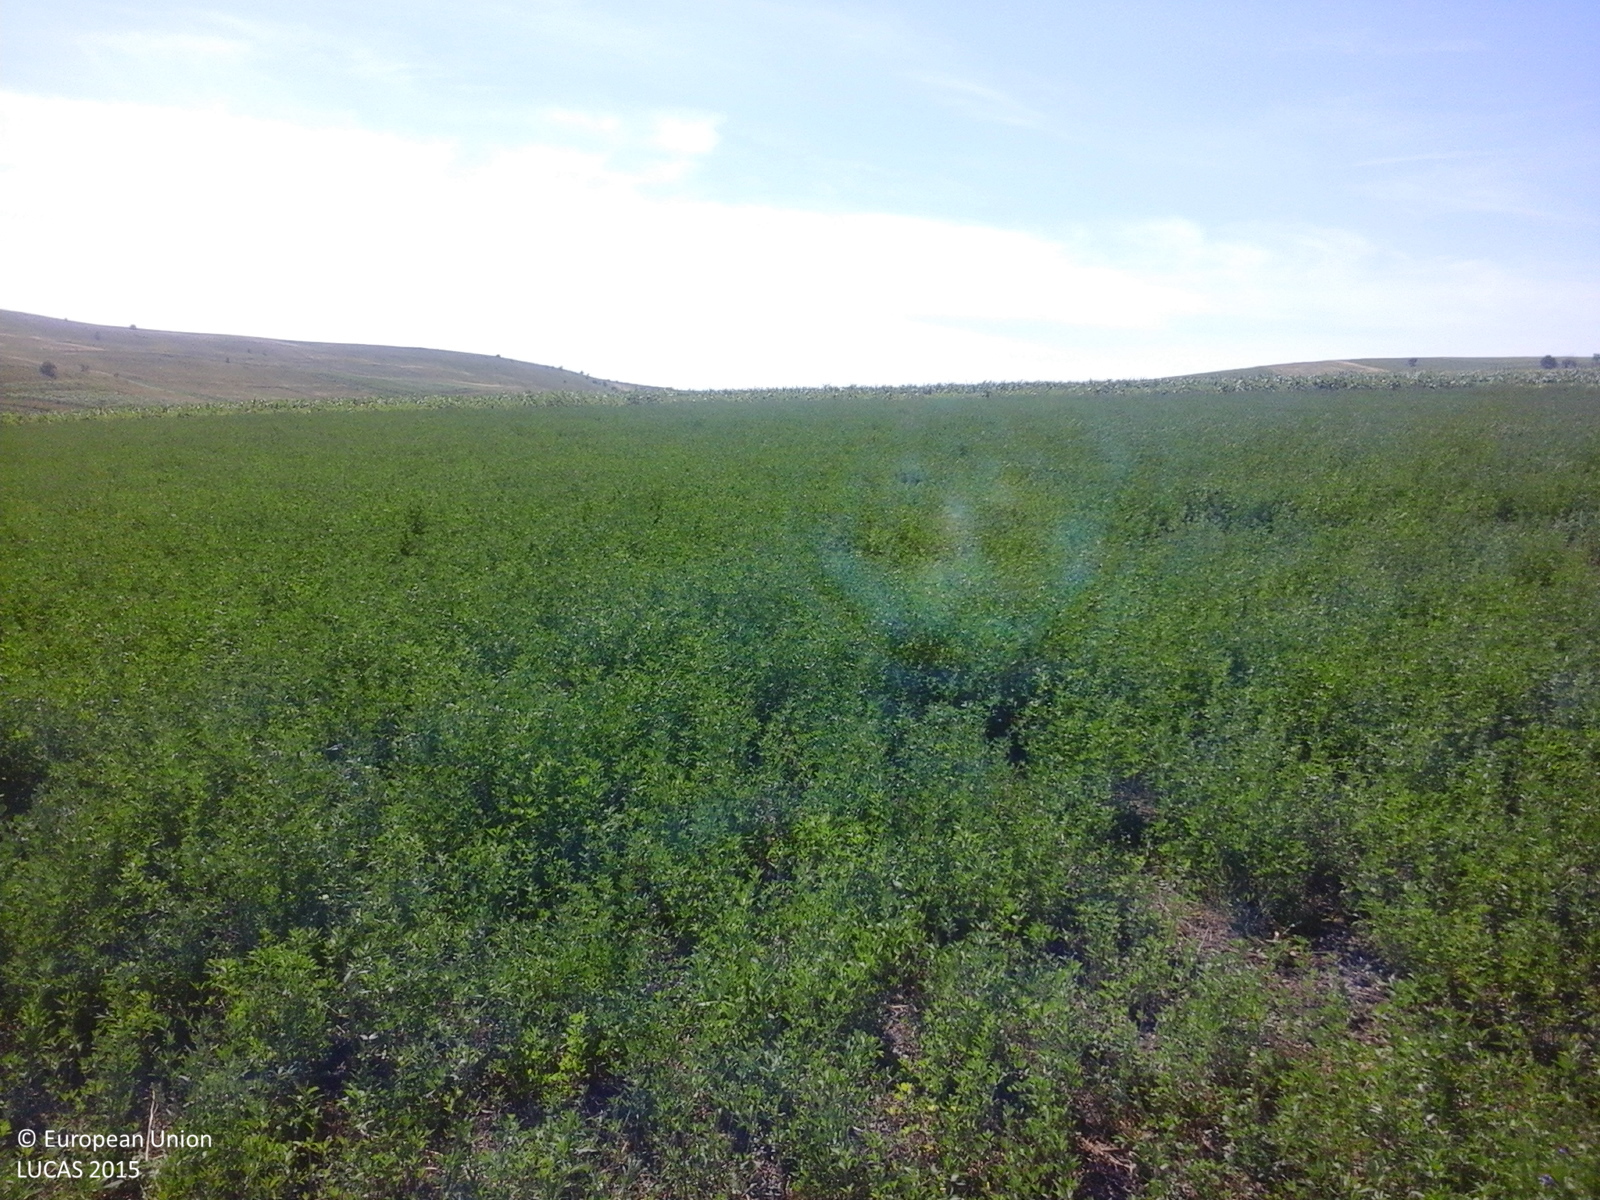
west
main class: Cropland
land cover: Lucerne
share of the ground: > 75 %
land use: Agriculture (excluding fallow land and kitchen gardens)
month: June
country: RO
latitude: 47.5591
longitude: 27.1869
